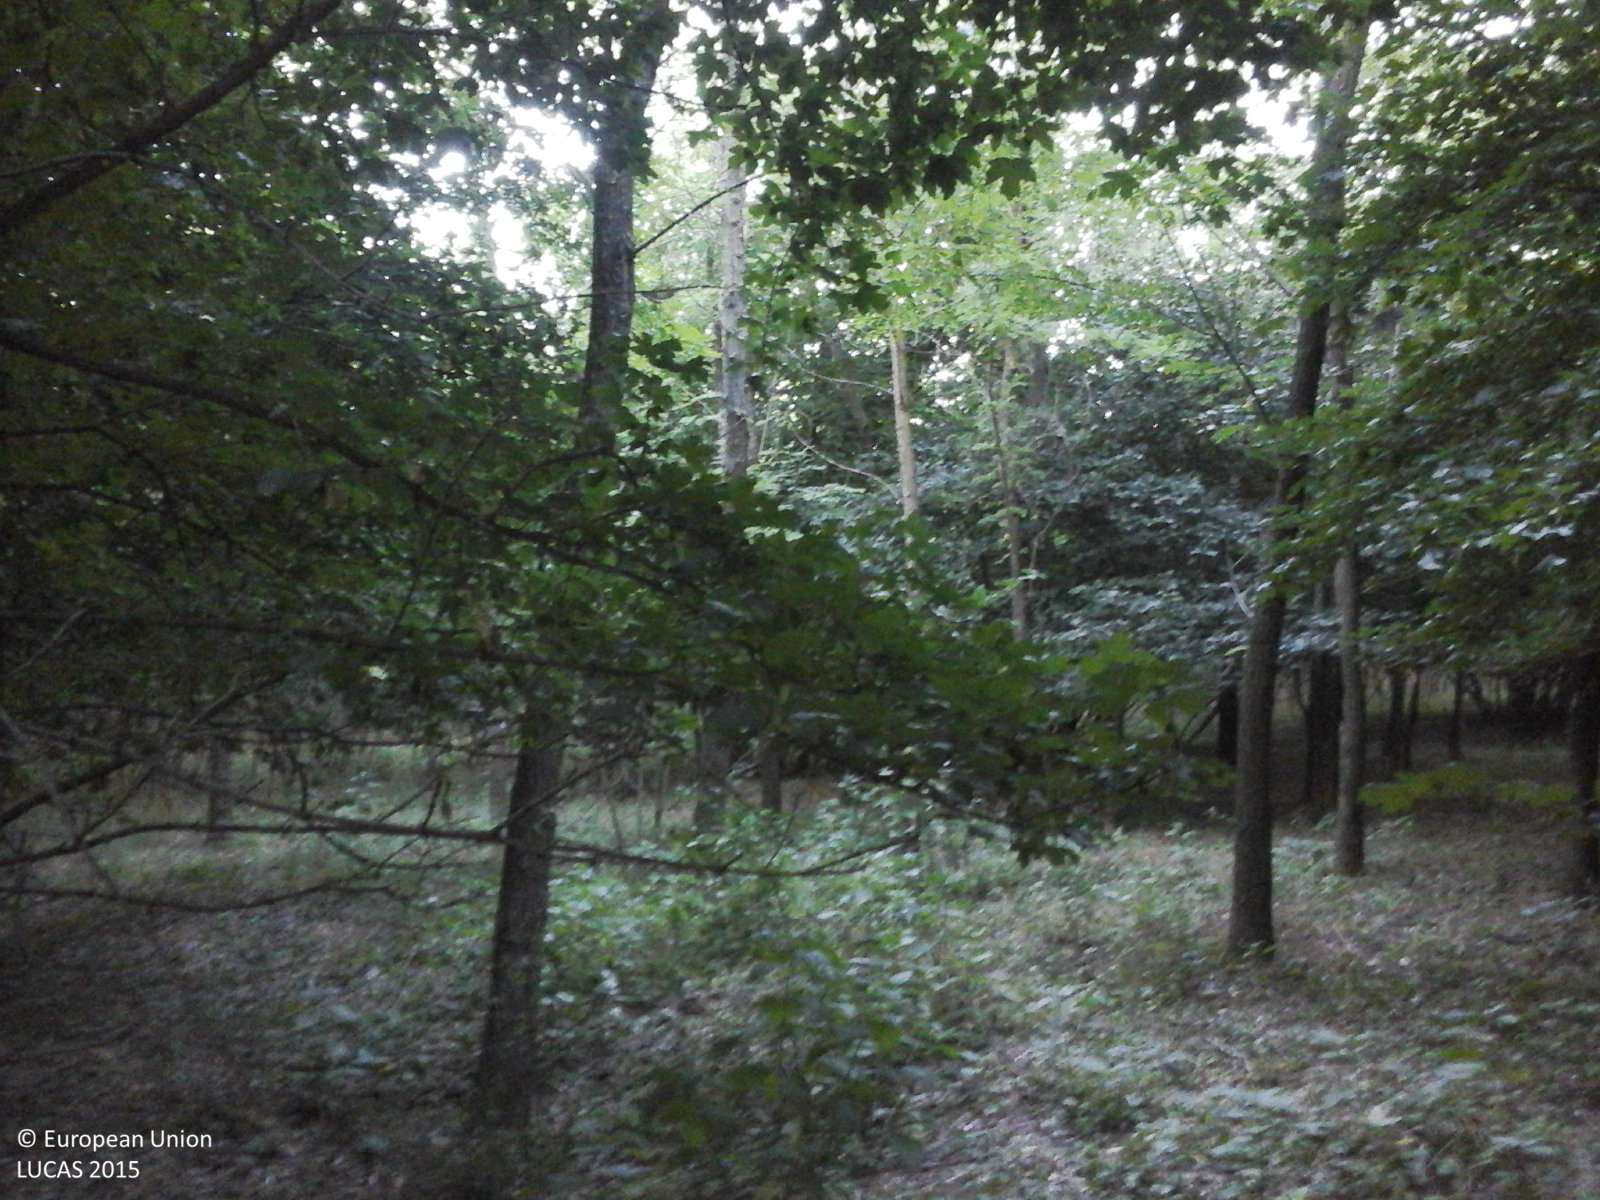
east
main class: Woodland
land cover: Broadleaved woodland
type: mesophytic deciduous forest
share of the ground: > 75 %
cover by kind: broadleaved forest trees 90 %, herbaceous plants 10 %
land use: Forestry
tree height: > 5 m
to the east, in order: Broadleaved woodland; Tracks; Broadleaved woodland
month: June
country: RO
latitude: 47.4071
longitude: 27.2172
